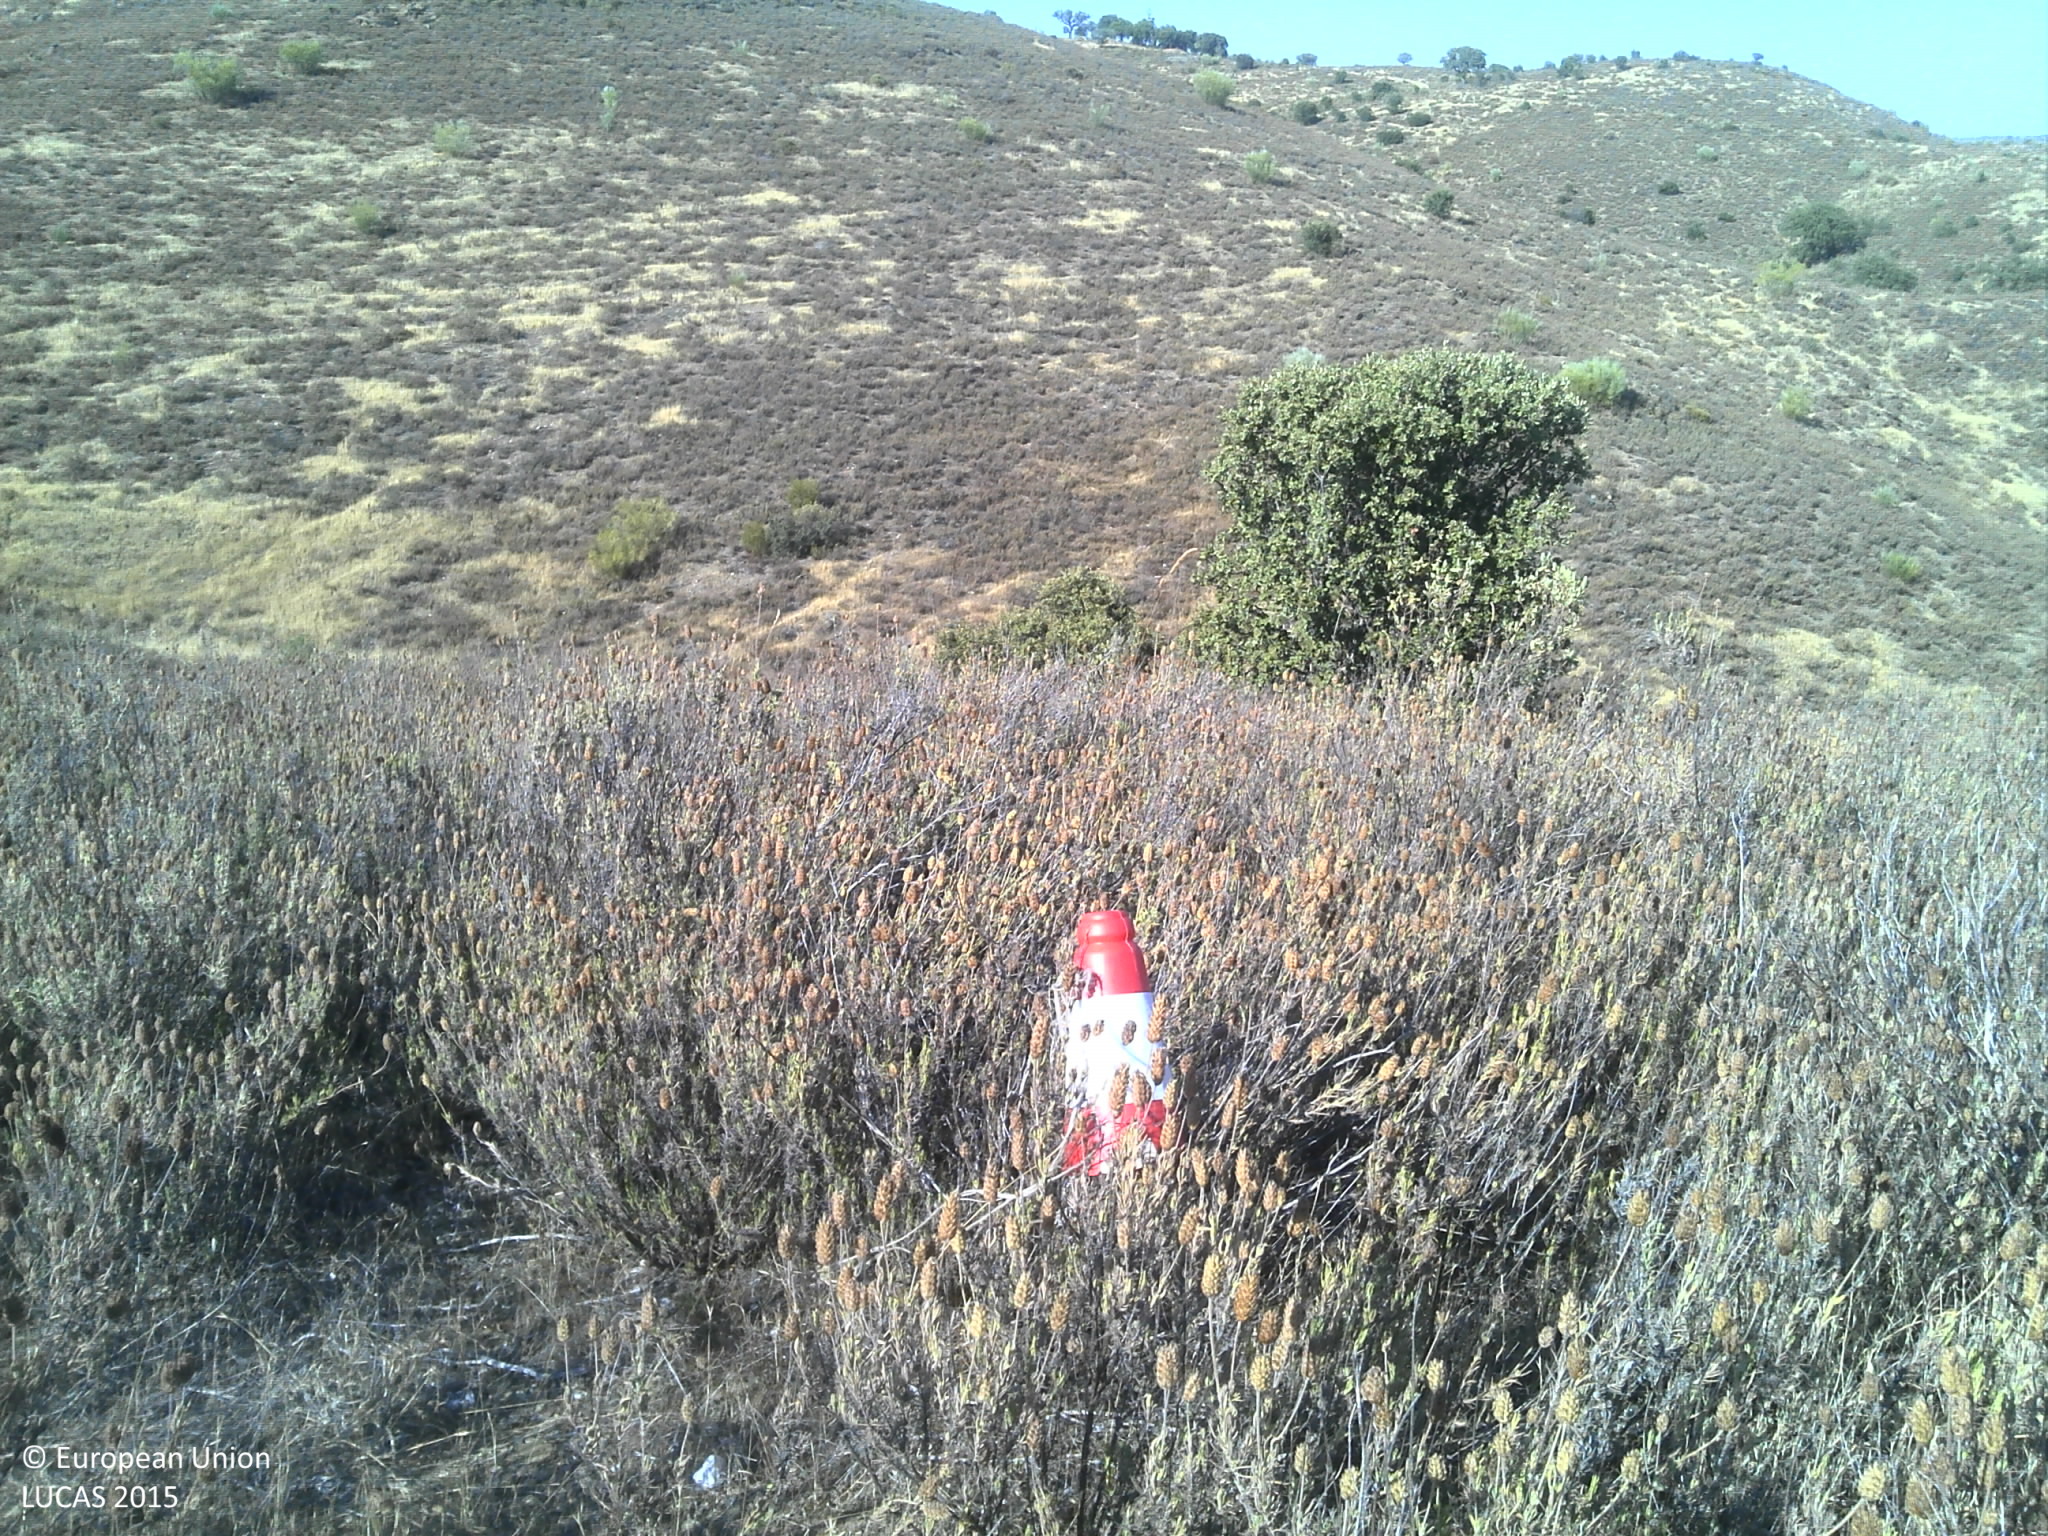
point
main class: Shrubland
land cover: Shrubland without tree cover
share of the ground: 50 - 75 %
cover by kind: shrubs 70 %, herbaceous plants 15 %, unconsolidated bare surface 10 %
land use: Abandoned areas
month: June
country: PT
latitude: 39.7304
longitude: -7.2068
